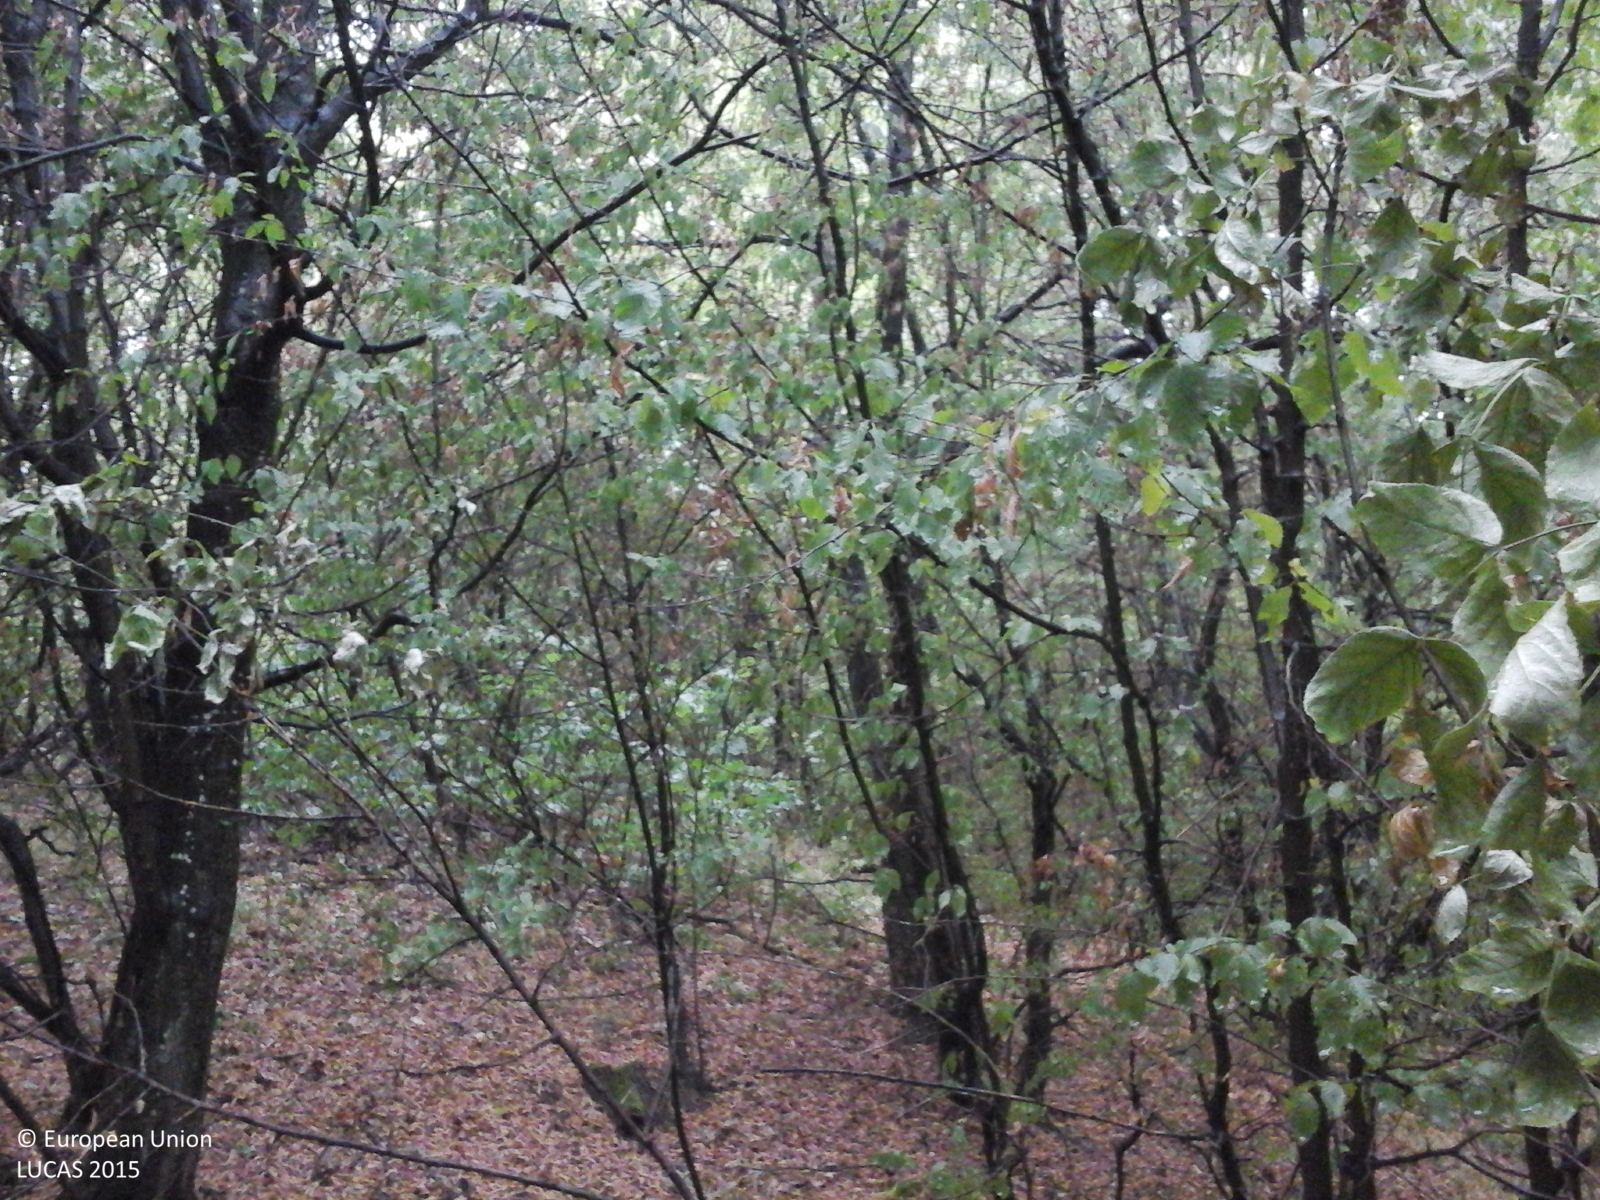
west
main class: Woodland
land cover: Broadleaved woodland
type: mesophytic deciduous forest
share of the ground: > 75 %
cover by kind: broadleaved forest trees 100 %
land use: Forestry
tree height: > 5 m
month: August
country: RO
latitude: 44.7152
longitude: 22.7041
